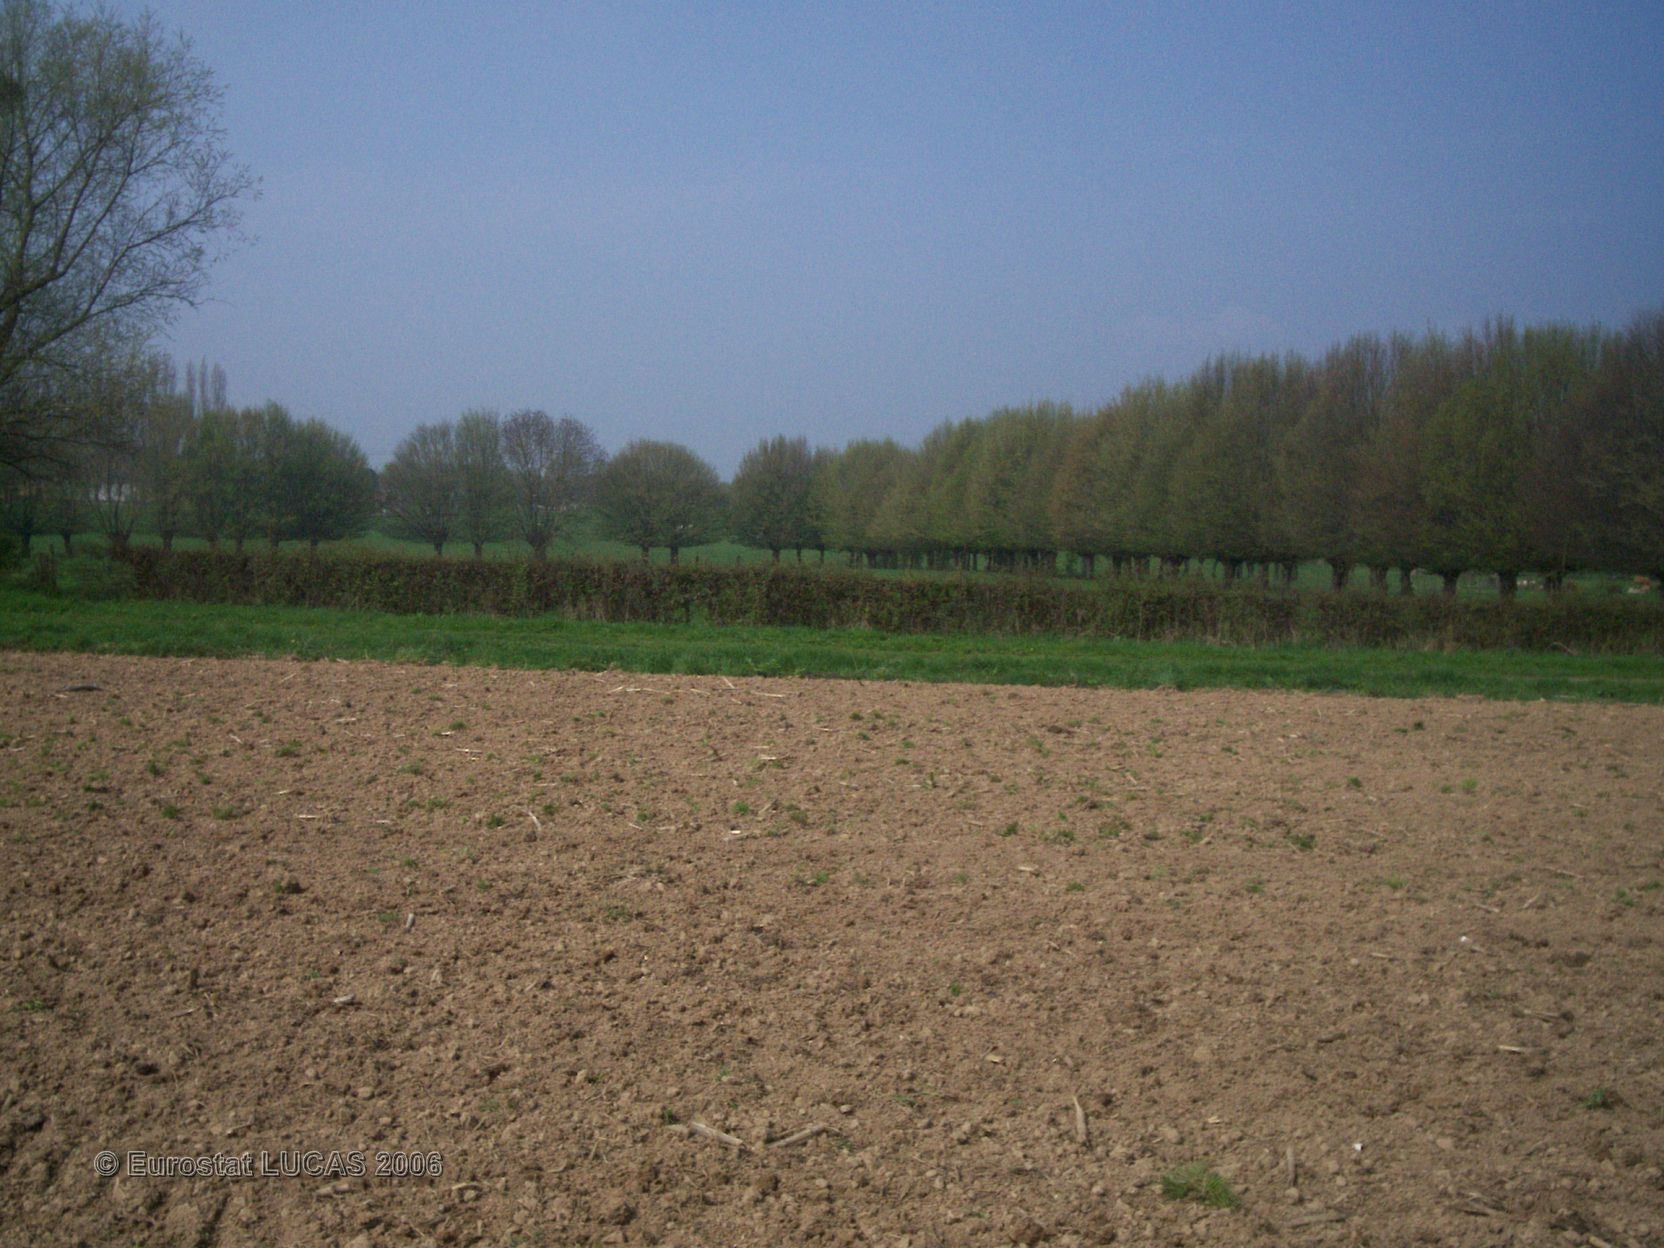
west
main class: Grassland
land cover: Grassland without tree/shrub cover
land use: Agriculture (excluding fallow land and kitchen gardens)
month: May
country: FR
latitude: 49.9937
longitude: 3.7302
